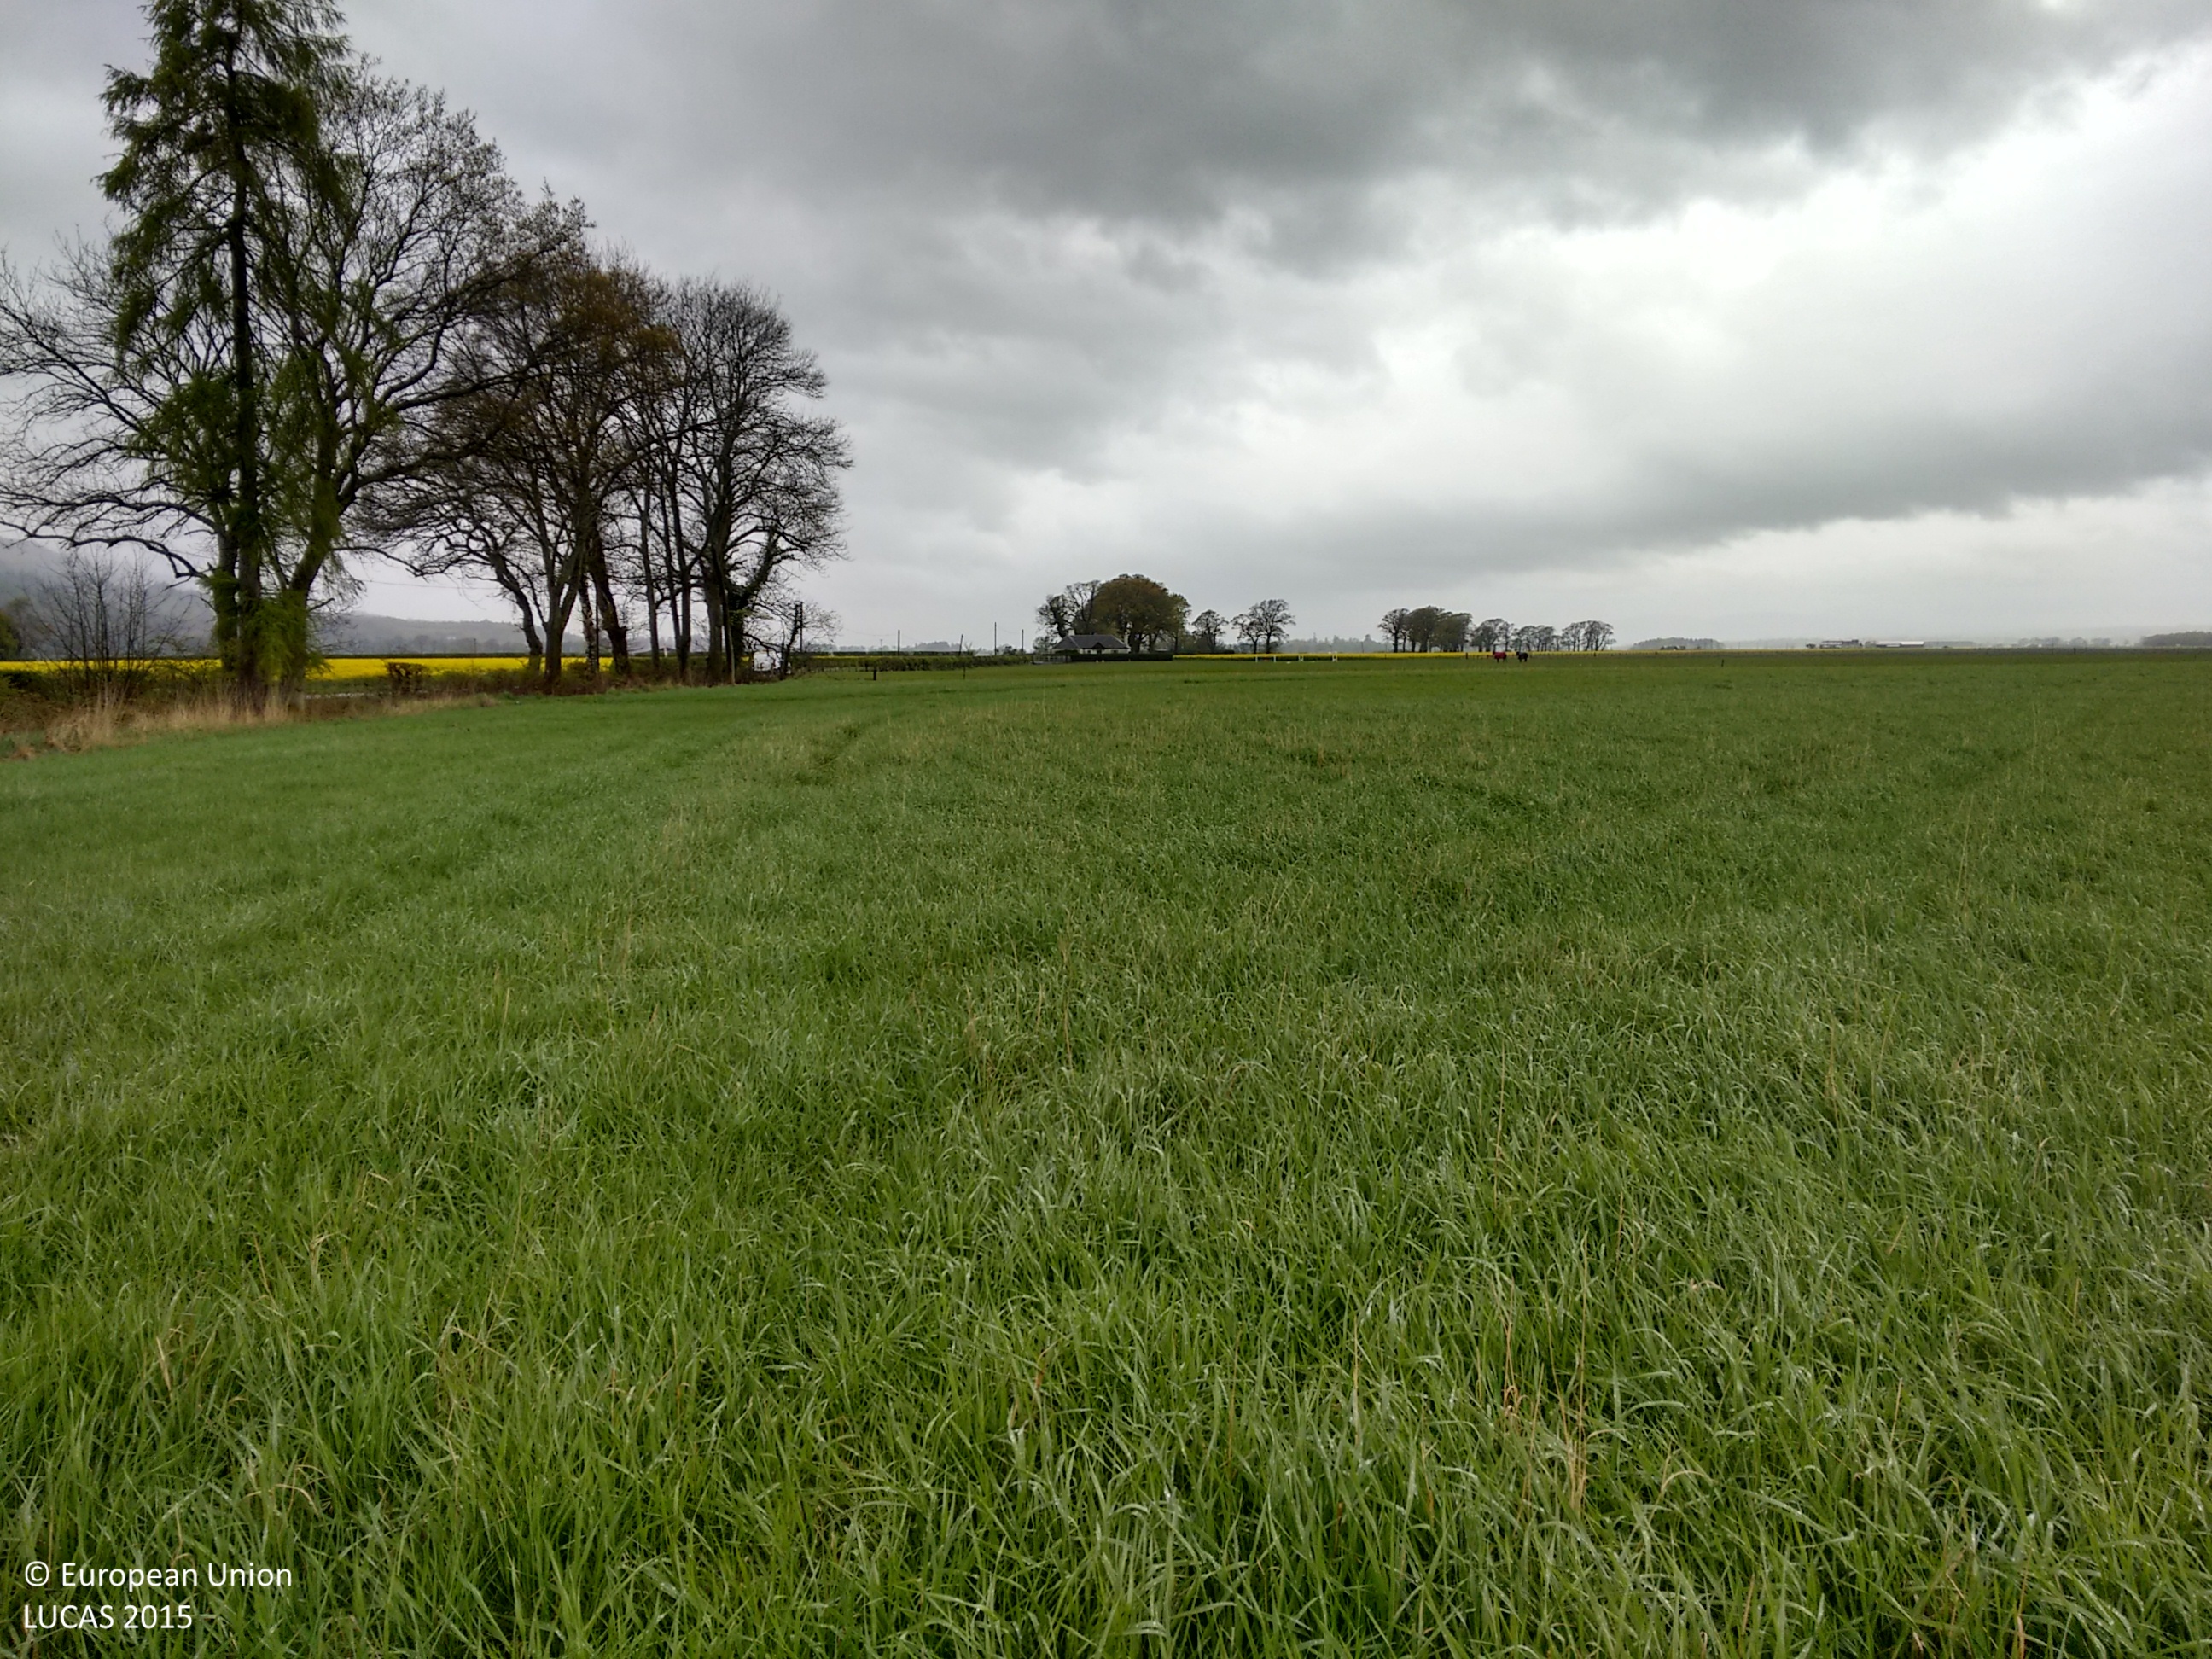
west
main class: Cropland
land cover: Mixed cereals for fodder
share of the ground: > 75 %
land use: Agriculture (excluding fallow land and kitchen gardens)
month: May
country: GB
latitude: 56.1277
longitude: -4.0028
